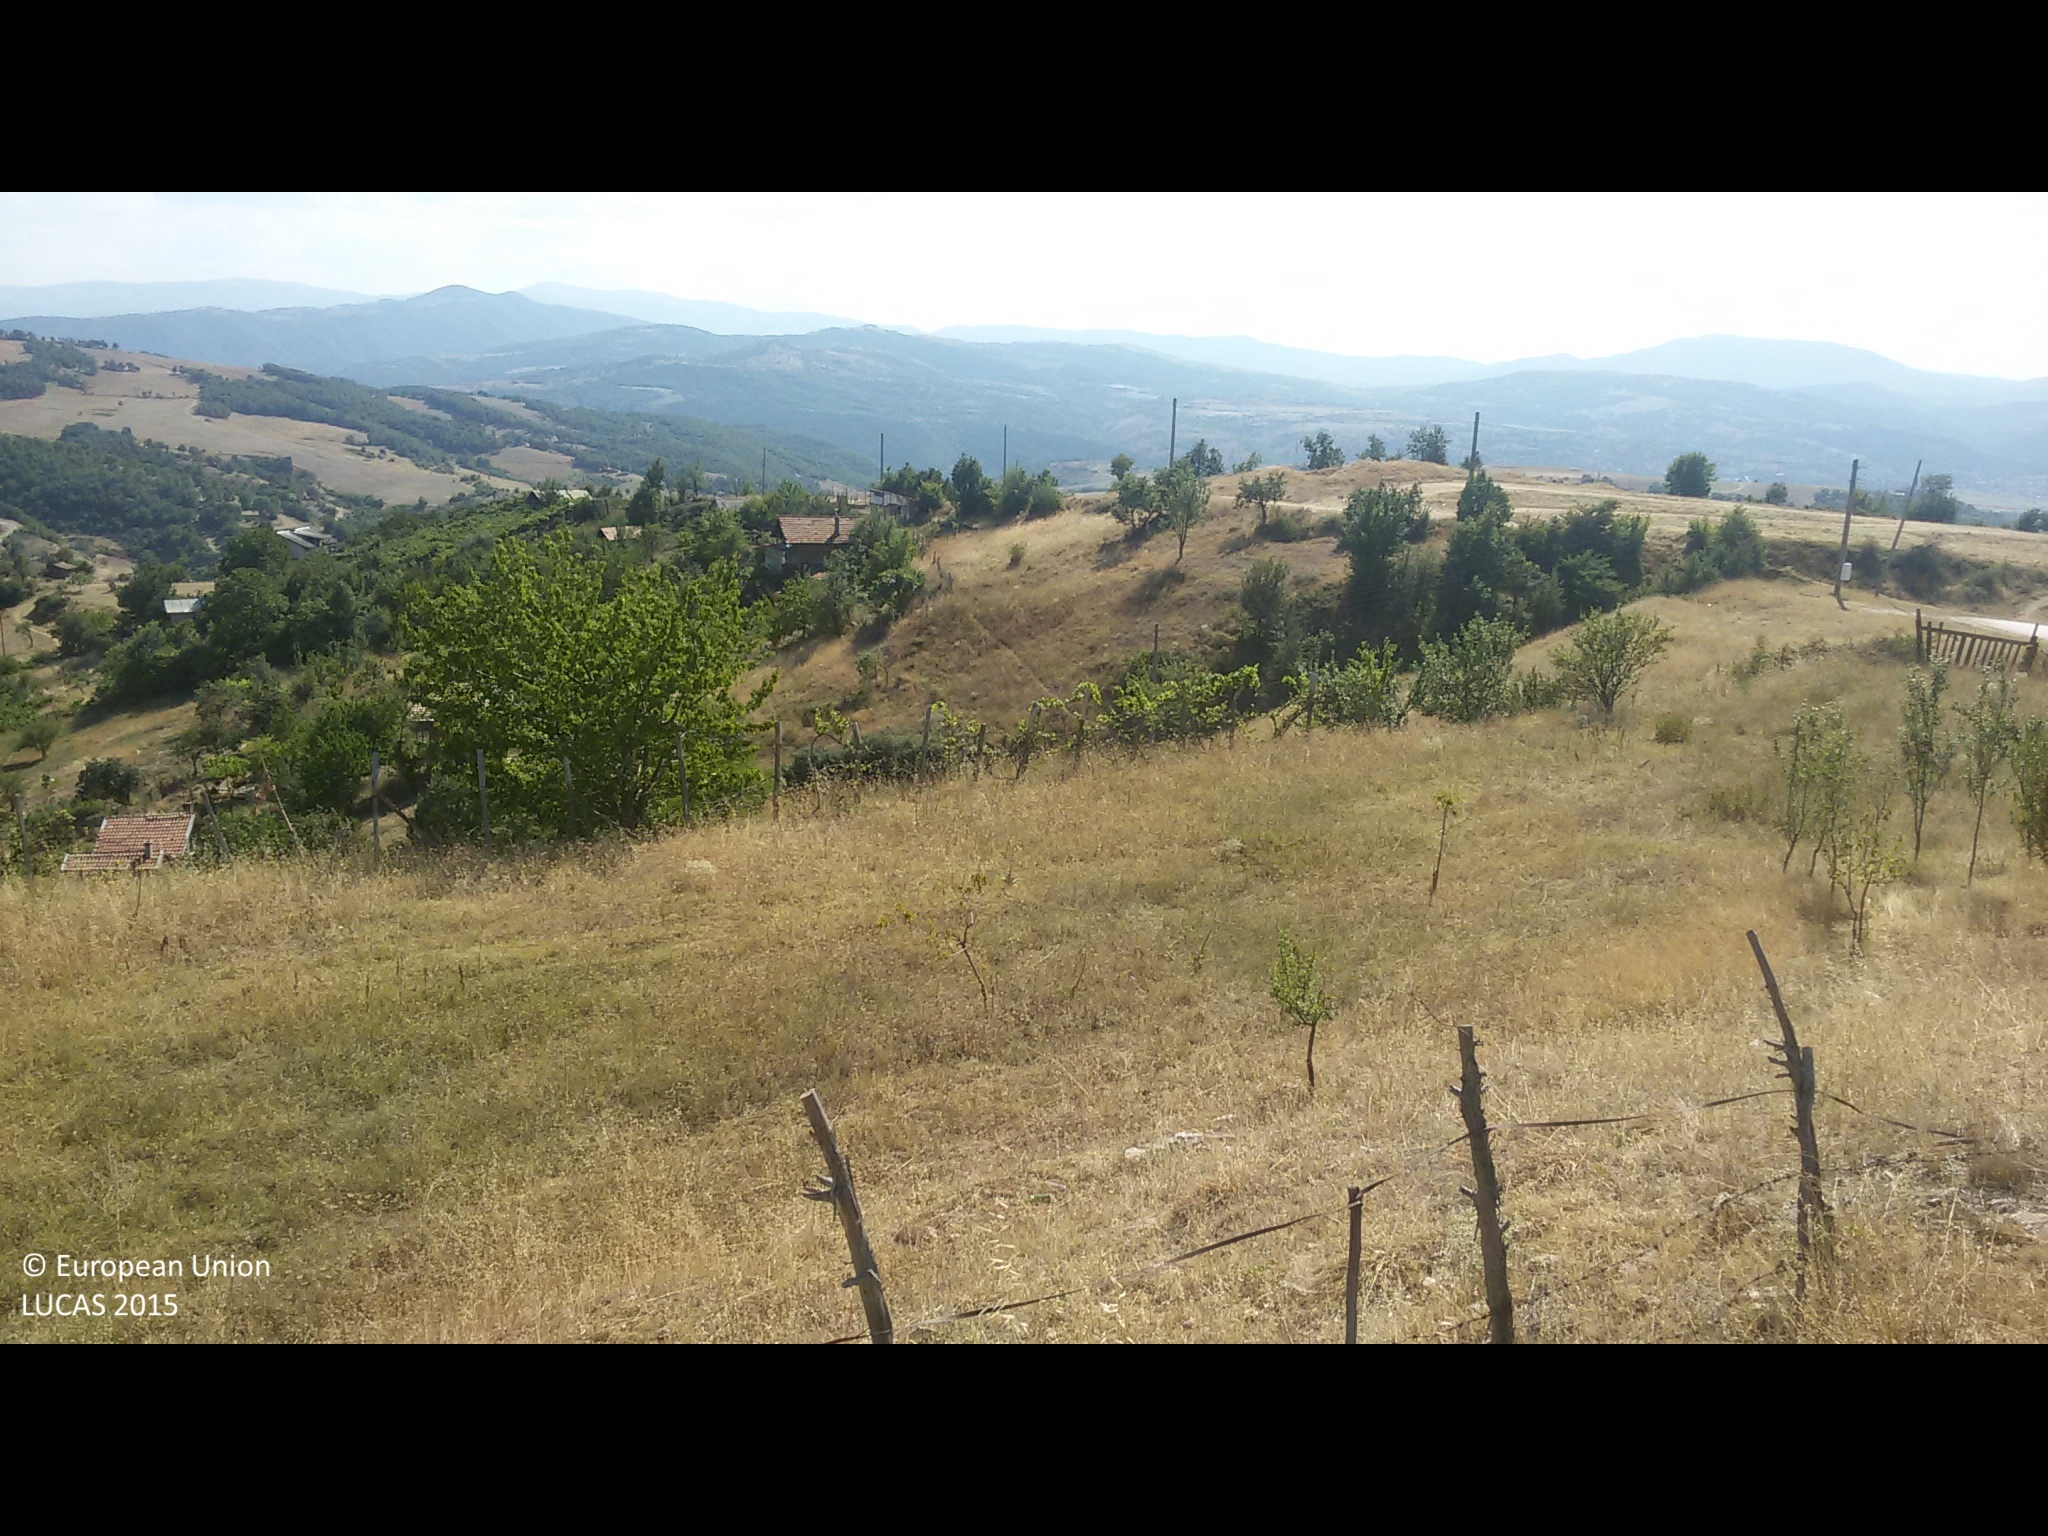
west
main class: Grassland
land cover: Grassland without tree/shrub cover
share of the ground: > 75 %
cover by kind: herbaceous plants 95 %, shrubs 5 %
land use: Agriculture (excluding fallow land and kitchen gardens)
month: August
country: BG
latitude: 41.9972
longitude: 23.1228
